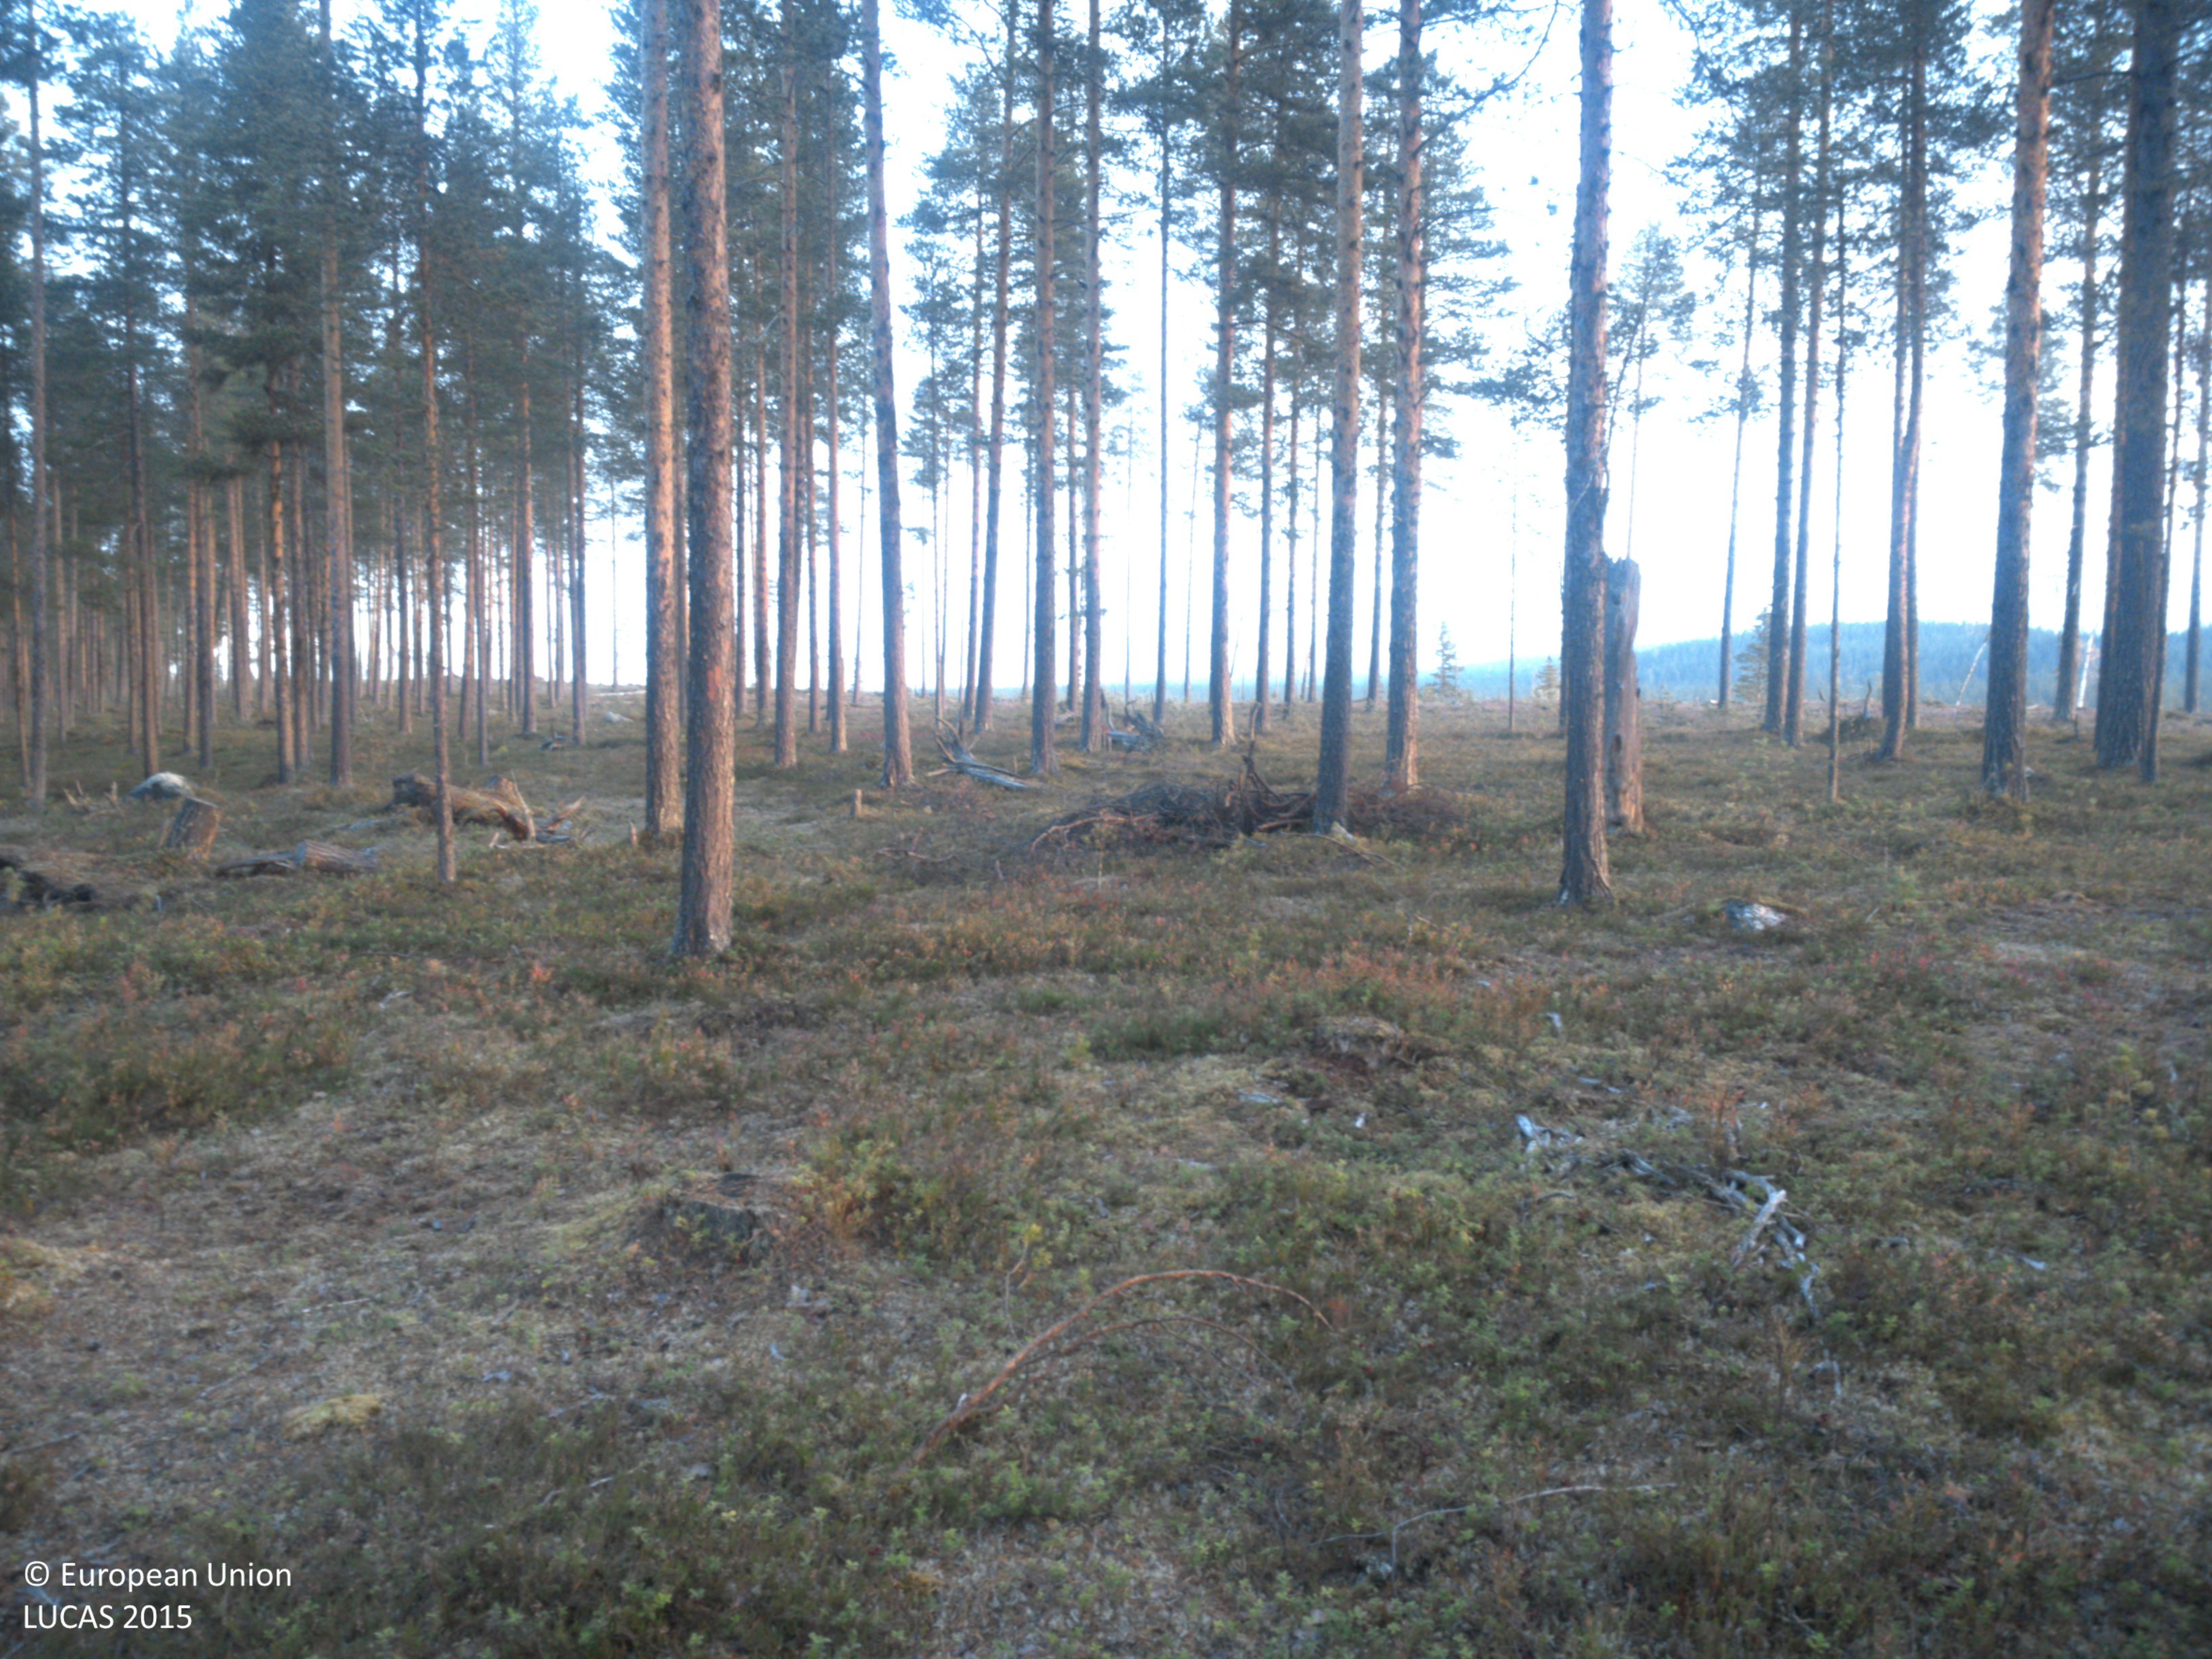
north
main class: Woodland
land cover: Pine dominated coniferous woodland
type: boreal forest
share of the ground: 25 - 50 %
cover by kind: coniferous forest trees 50 %, shrubs 25 %, lichens and mosses 15 %, herbaceous plants 10 %
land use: Forestry
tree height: > 5 m
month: October
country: SE
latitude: 64.7977
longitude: 18.3216
